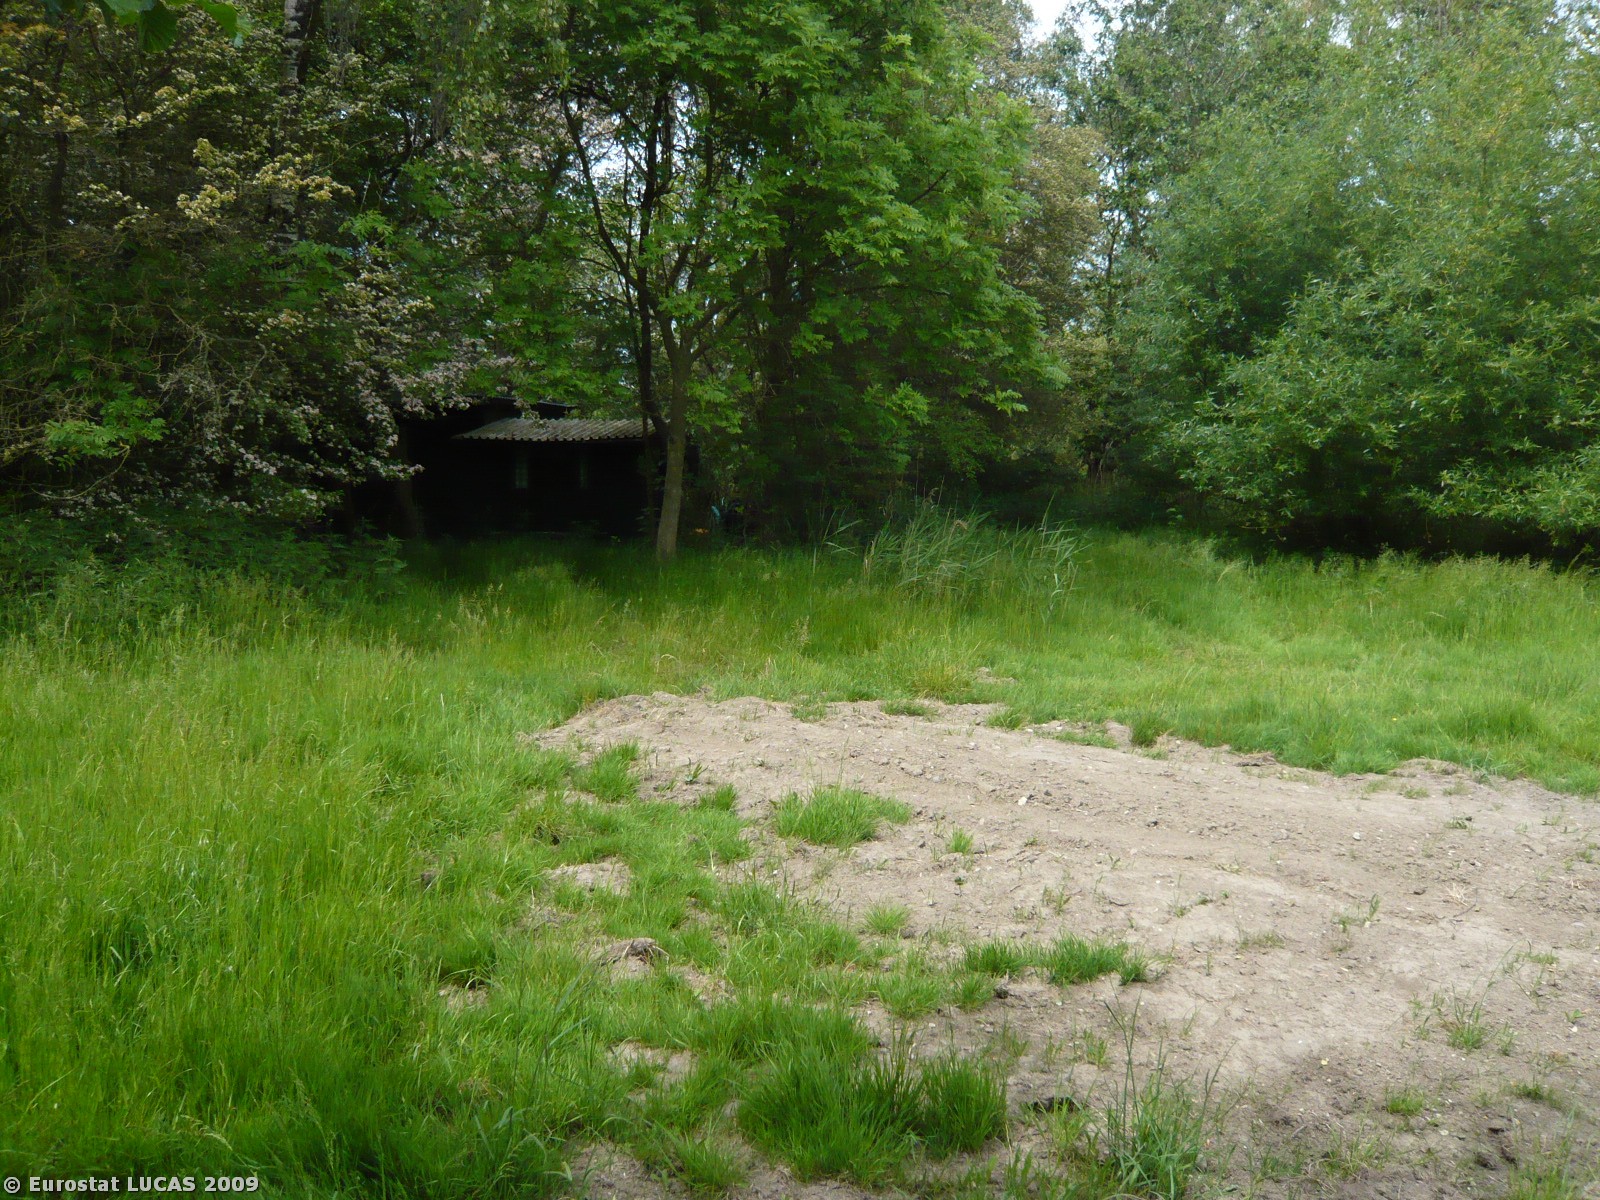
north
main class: Woodland
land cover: Broadleaved woodland
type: mire and swamp forests
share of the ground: > 75 %
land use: Unused
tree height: > 5 m
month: June
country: DK
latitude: 55.2456
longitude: 11.3673
